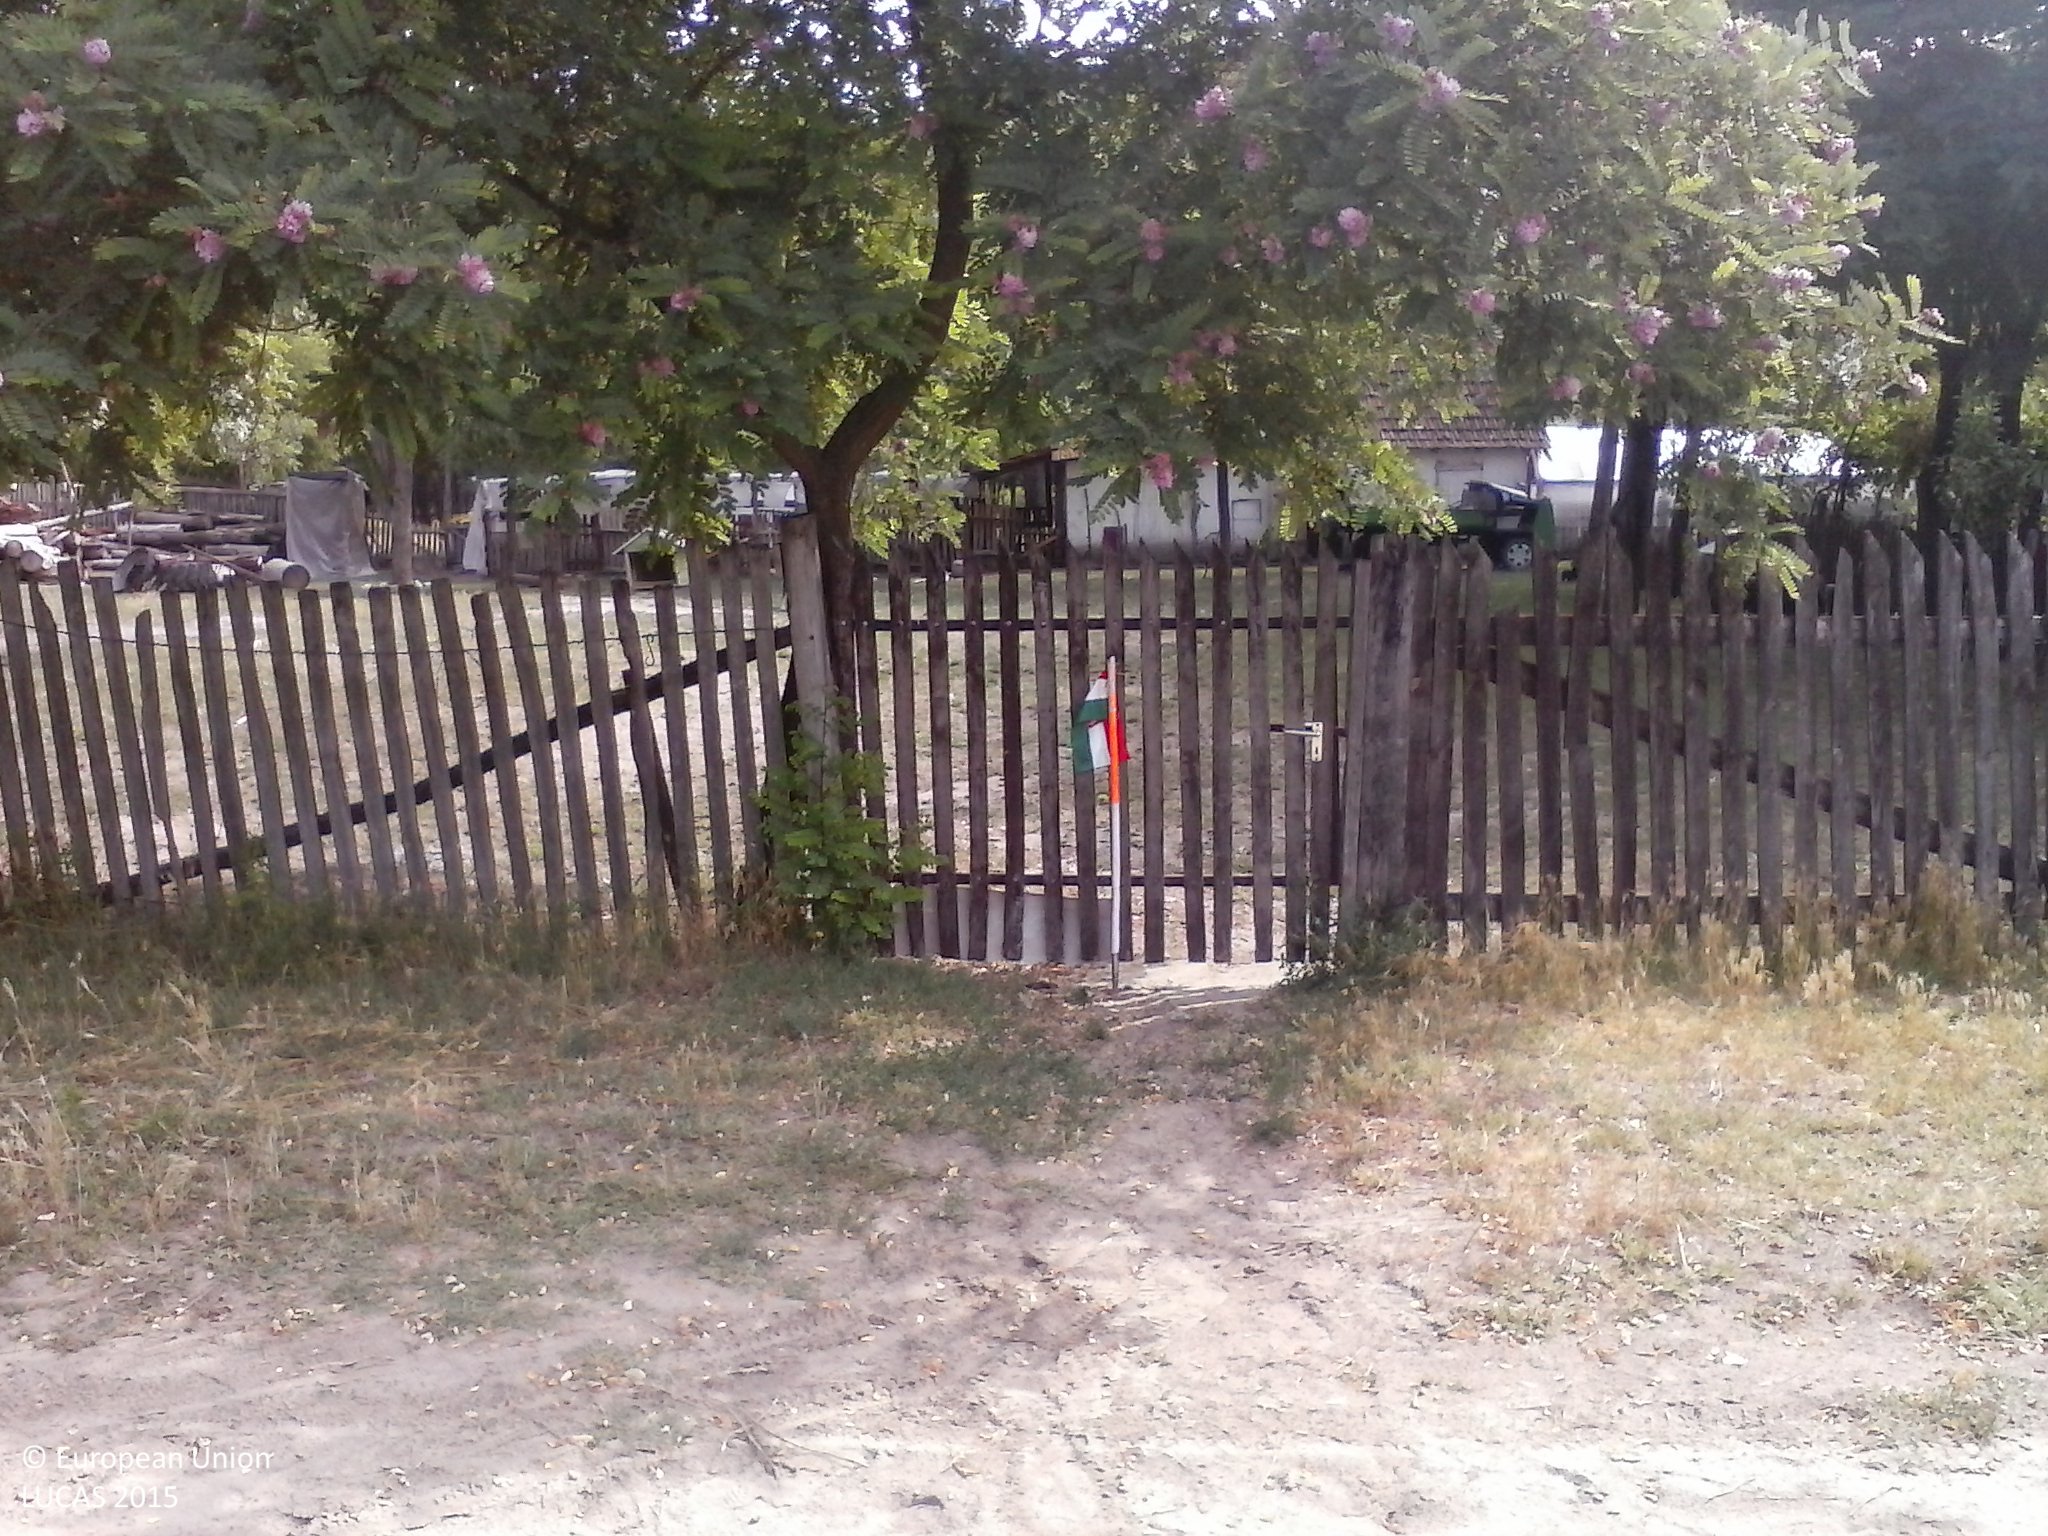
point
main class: Artificial land
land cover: Non built-up area features
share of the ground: > 75 %
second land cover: Spontaneously vegetated surfaces
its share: > 75 %
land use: Residential
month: June
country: HU
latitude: 46.2401
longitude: 19.6532
